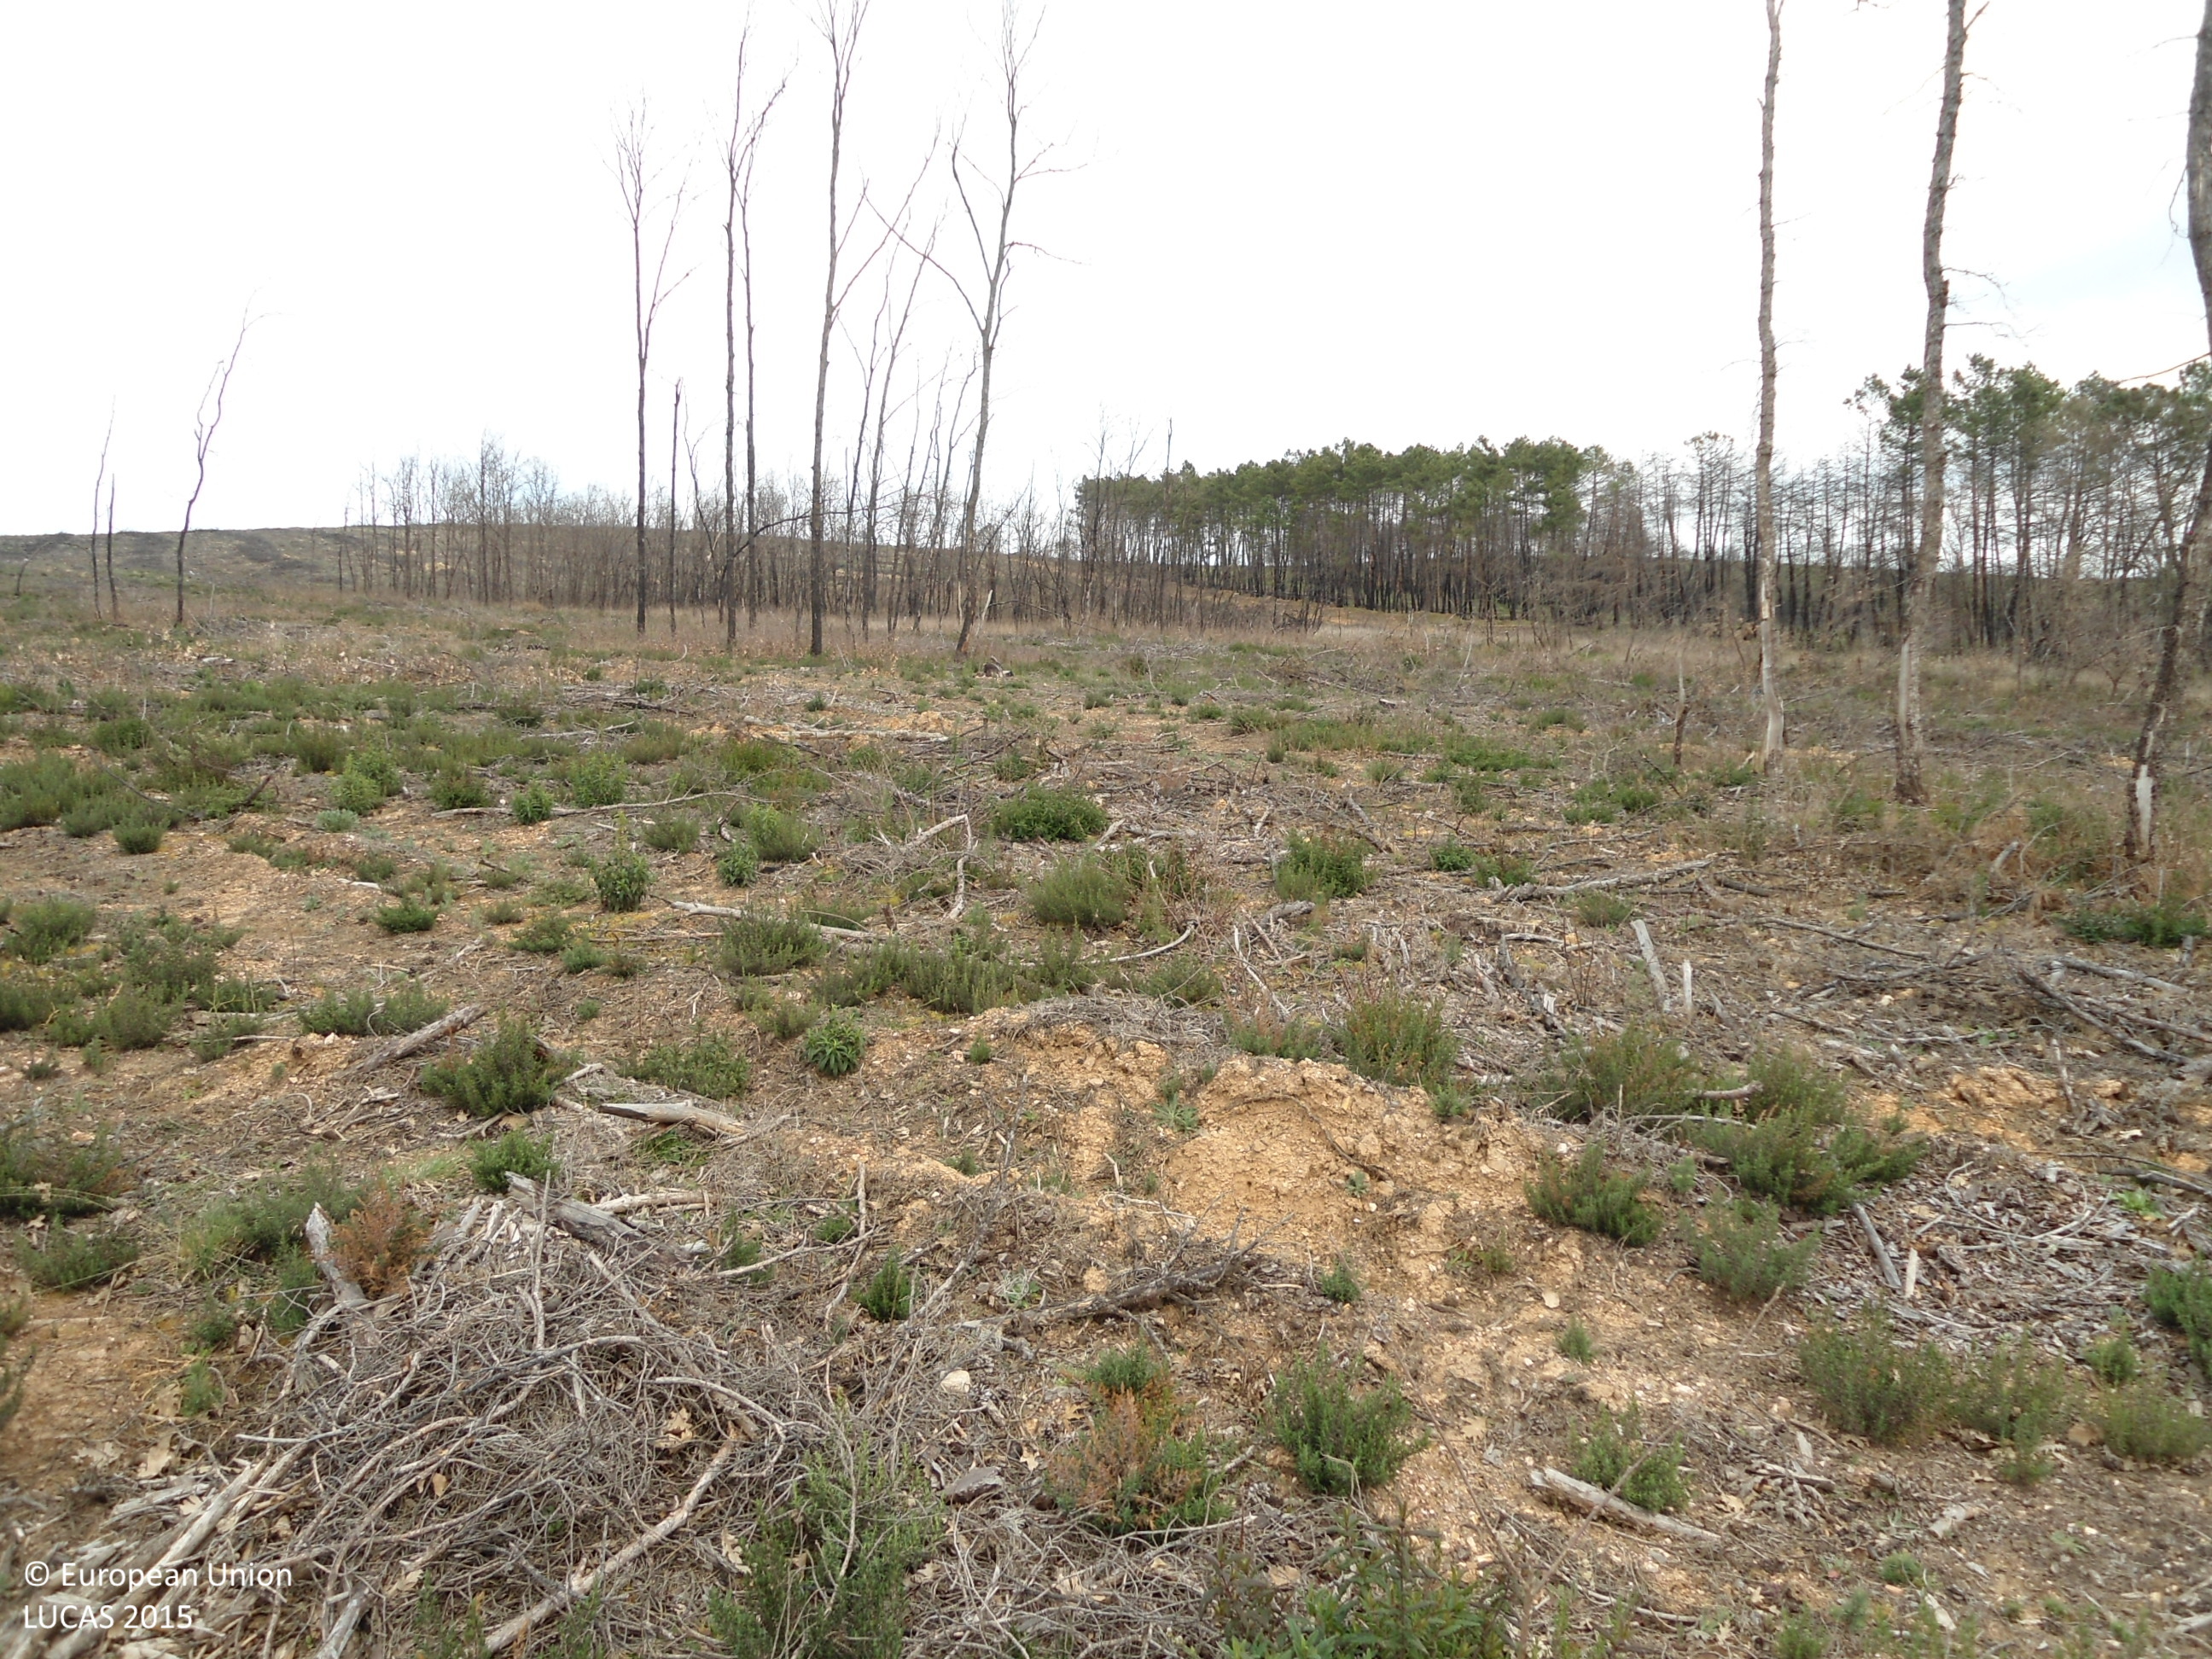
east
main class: Shrubland
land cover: Shrubland without tree cover
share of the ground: > 75 %
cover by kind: shrubs 100 %
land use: Forestry
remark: Burnt area
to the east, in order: Shrubland without tree cover; Grassland without tree/shrub cover; Tracks; Pine dominated coniferous woodland; Shrubland without tree cover
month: April
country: ES
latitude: 41.6582
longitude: -6.2757
